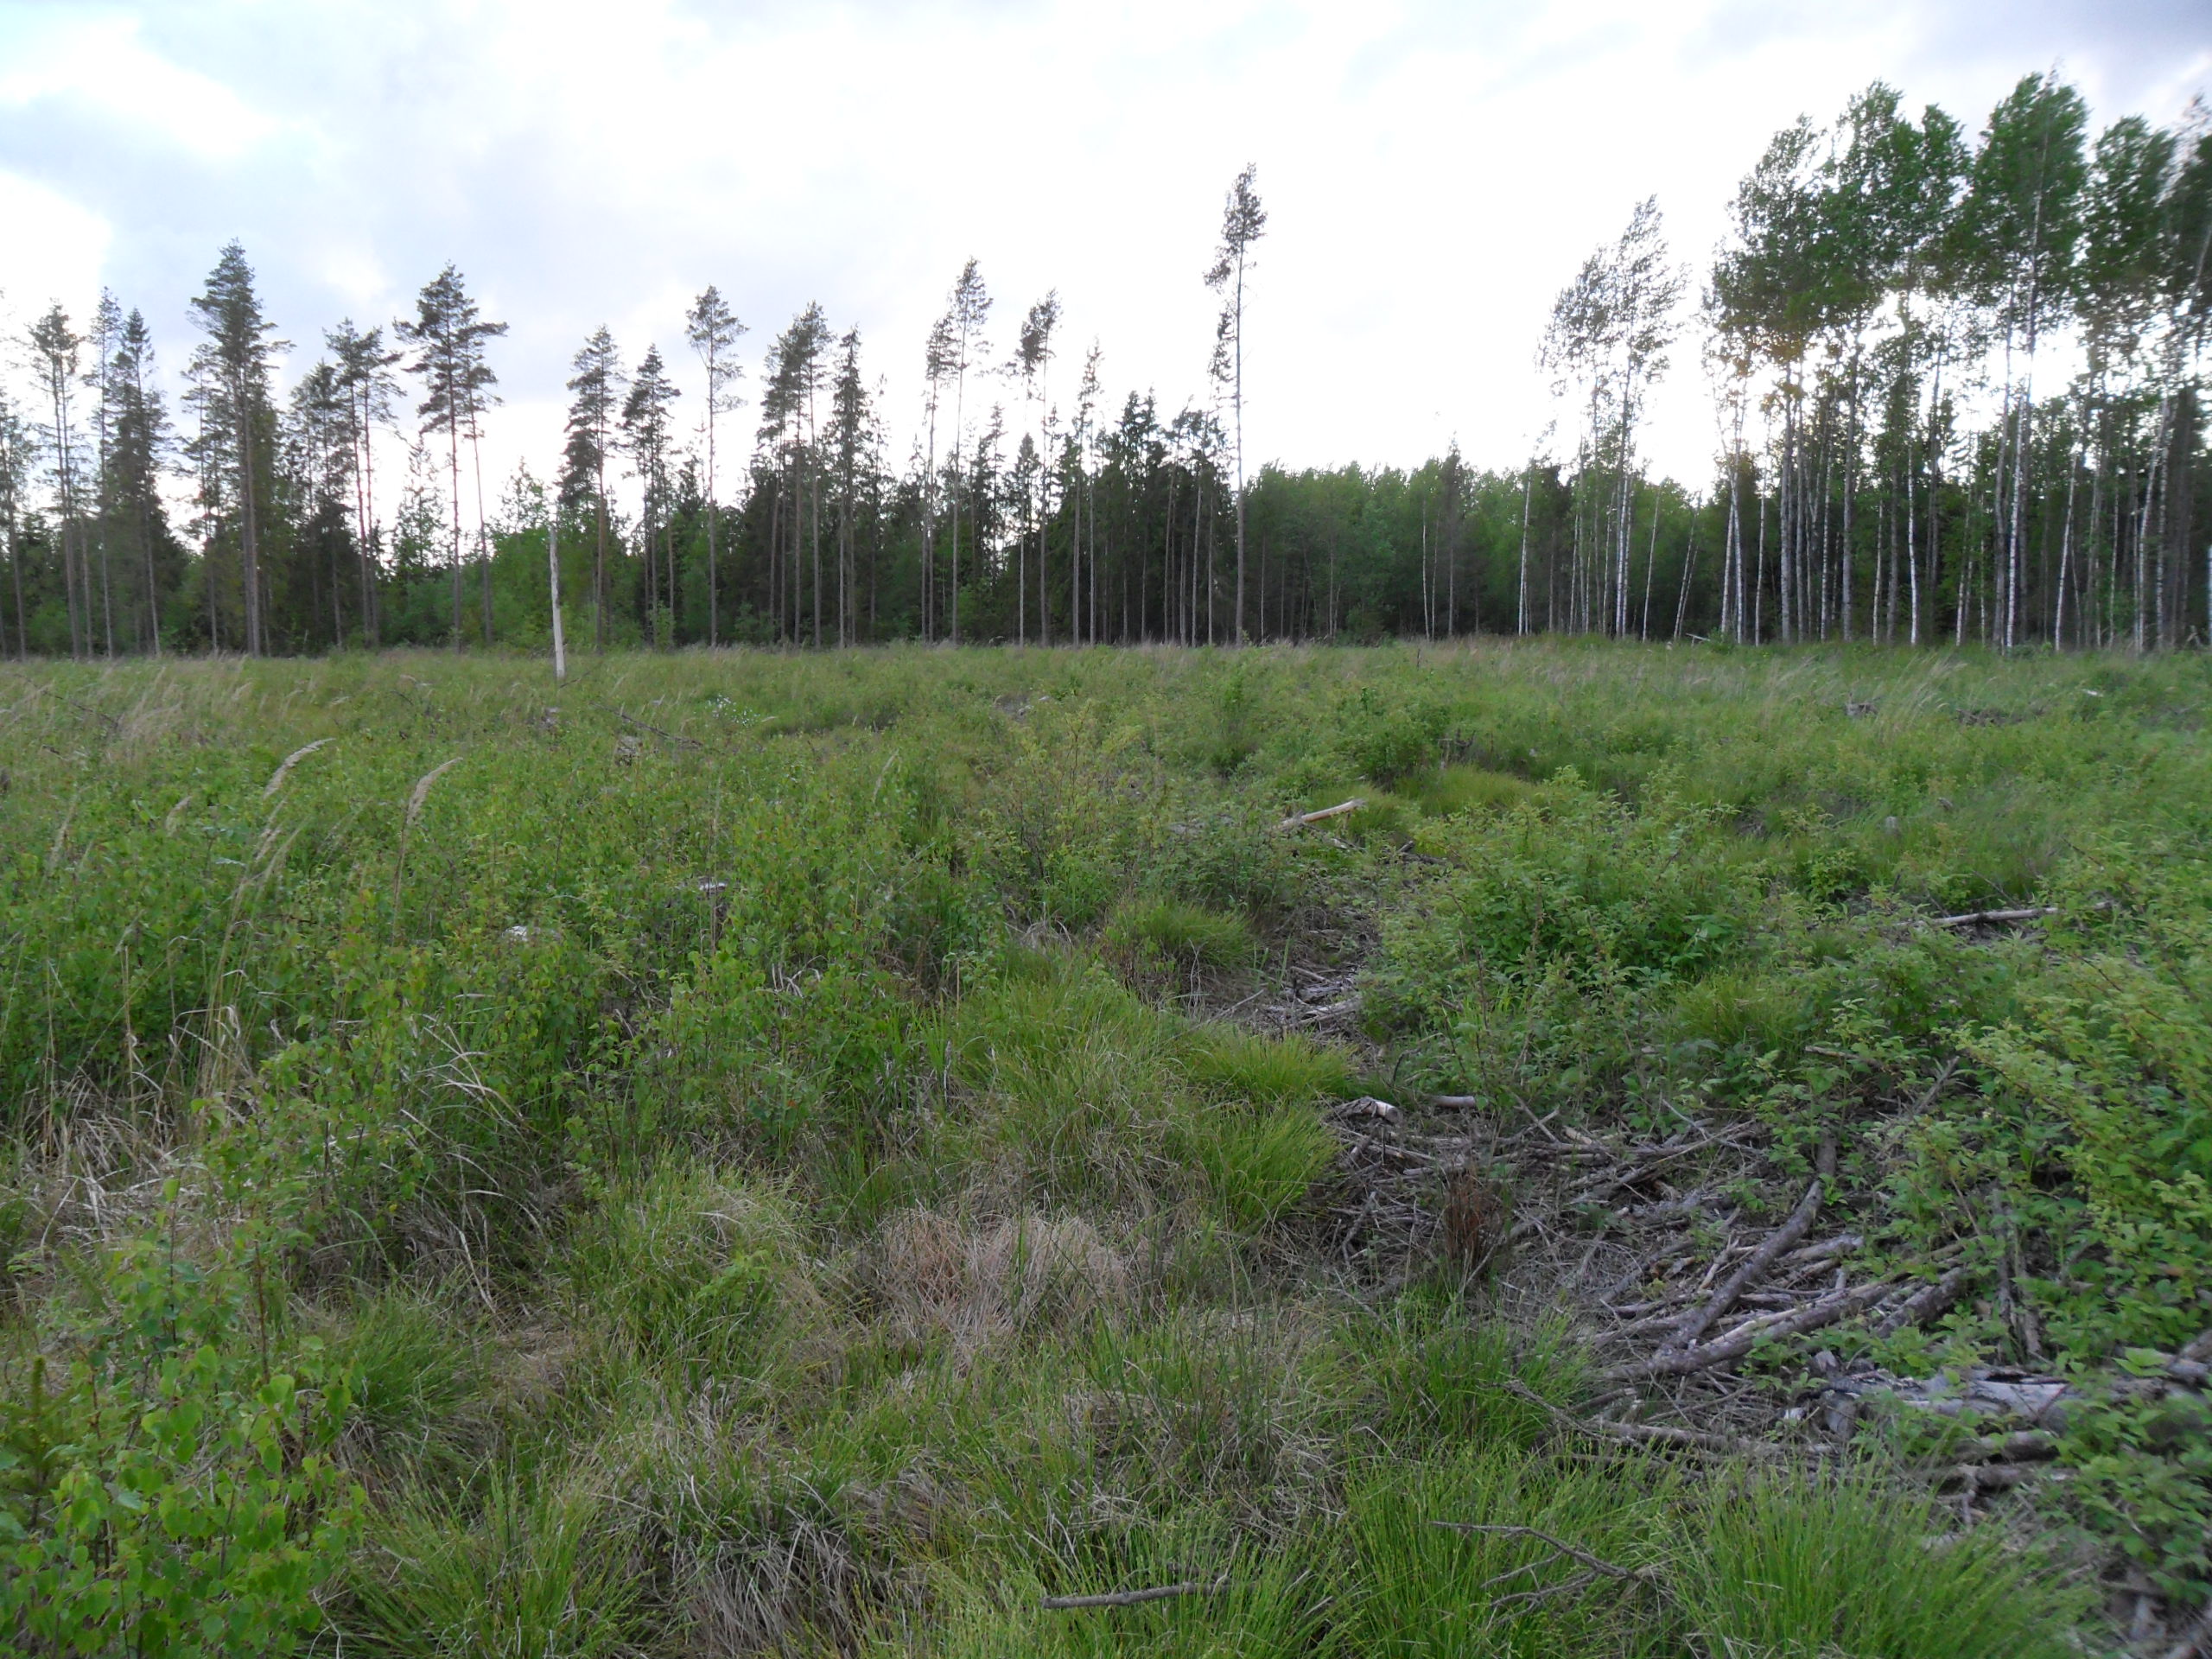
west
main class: Grassland
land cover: Grassland with sparse tree/shrub cover
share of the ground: > 75 %
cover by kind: herbaceous plants 85 %, shrubs 10 %, broadleaved forest trees 5 %
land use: Forestry
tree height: < 5 m
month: June
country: LV
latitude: 57.3093
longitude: 22.4536
